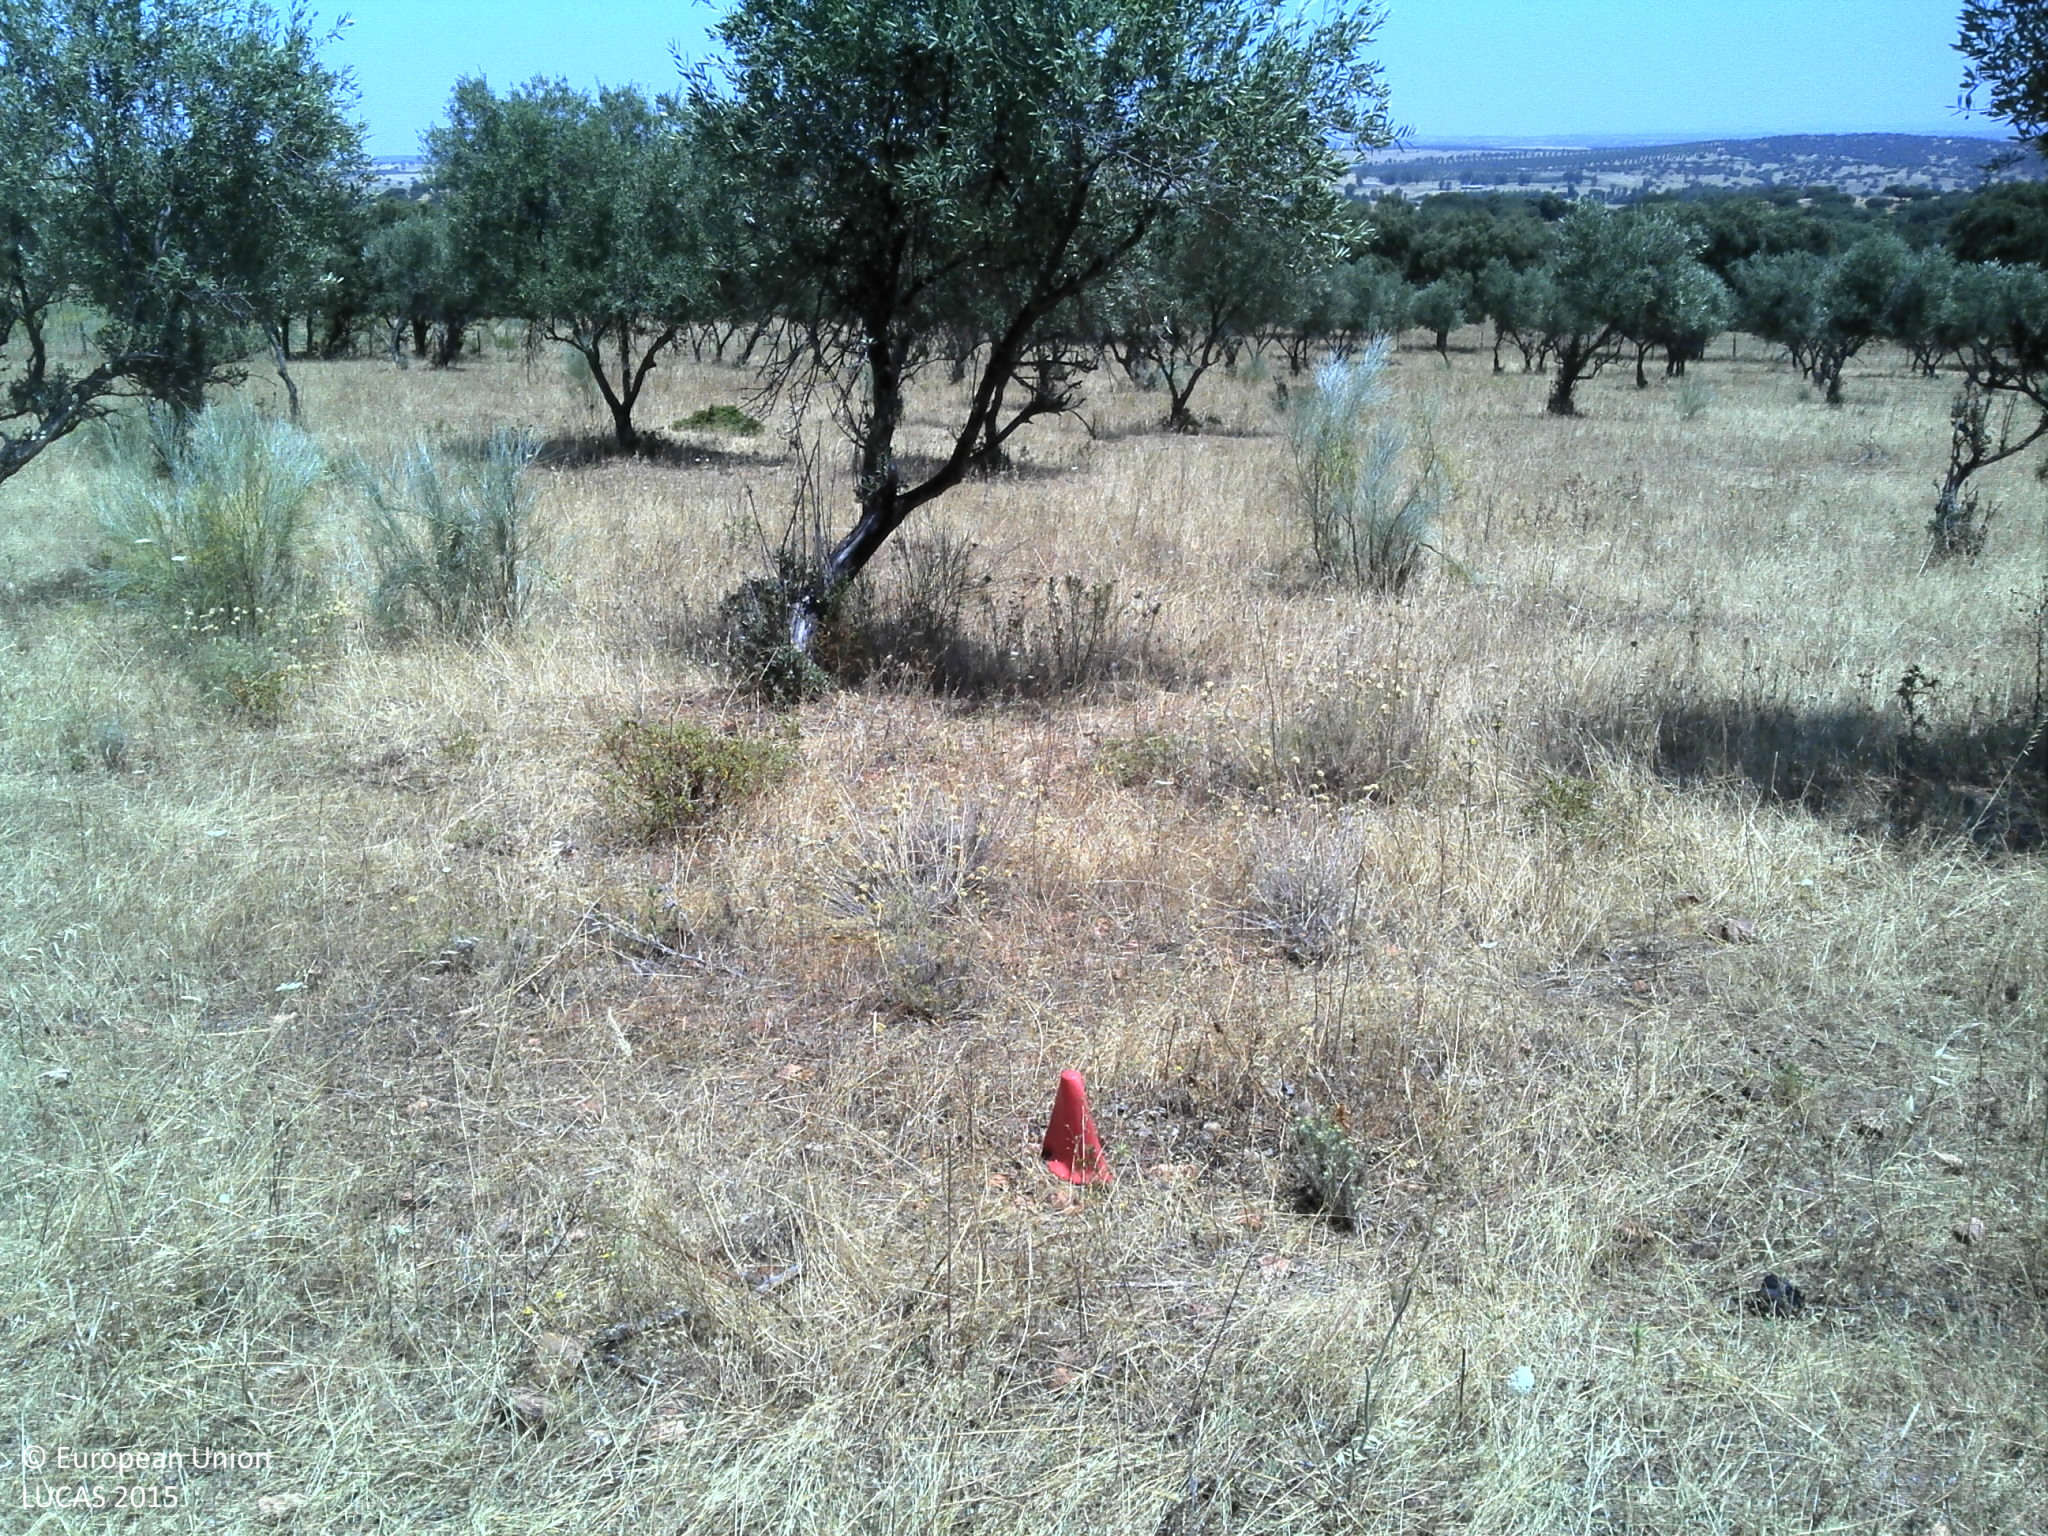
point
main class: Cropland
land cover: Olive groves
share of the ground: 25 - 50 %
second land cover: Grassland without tree/shrub cover
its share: 50 - 75 %
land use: Agriculture (excluding fallow land and kitchen gardens)
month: June
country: PT
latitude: 38.0519
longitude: -7.3036
